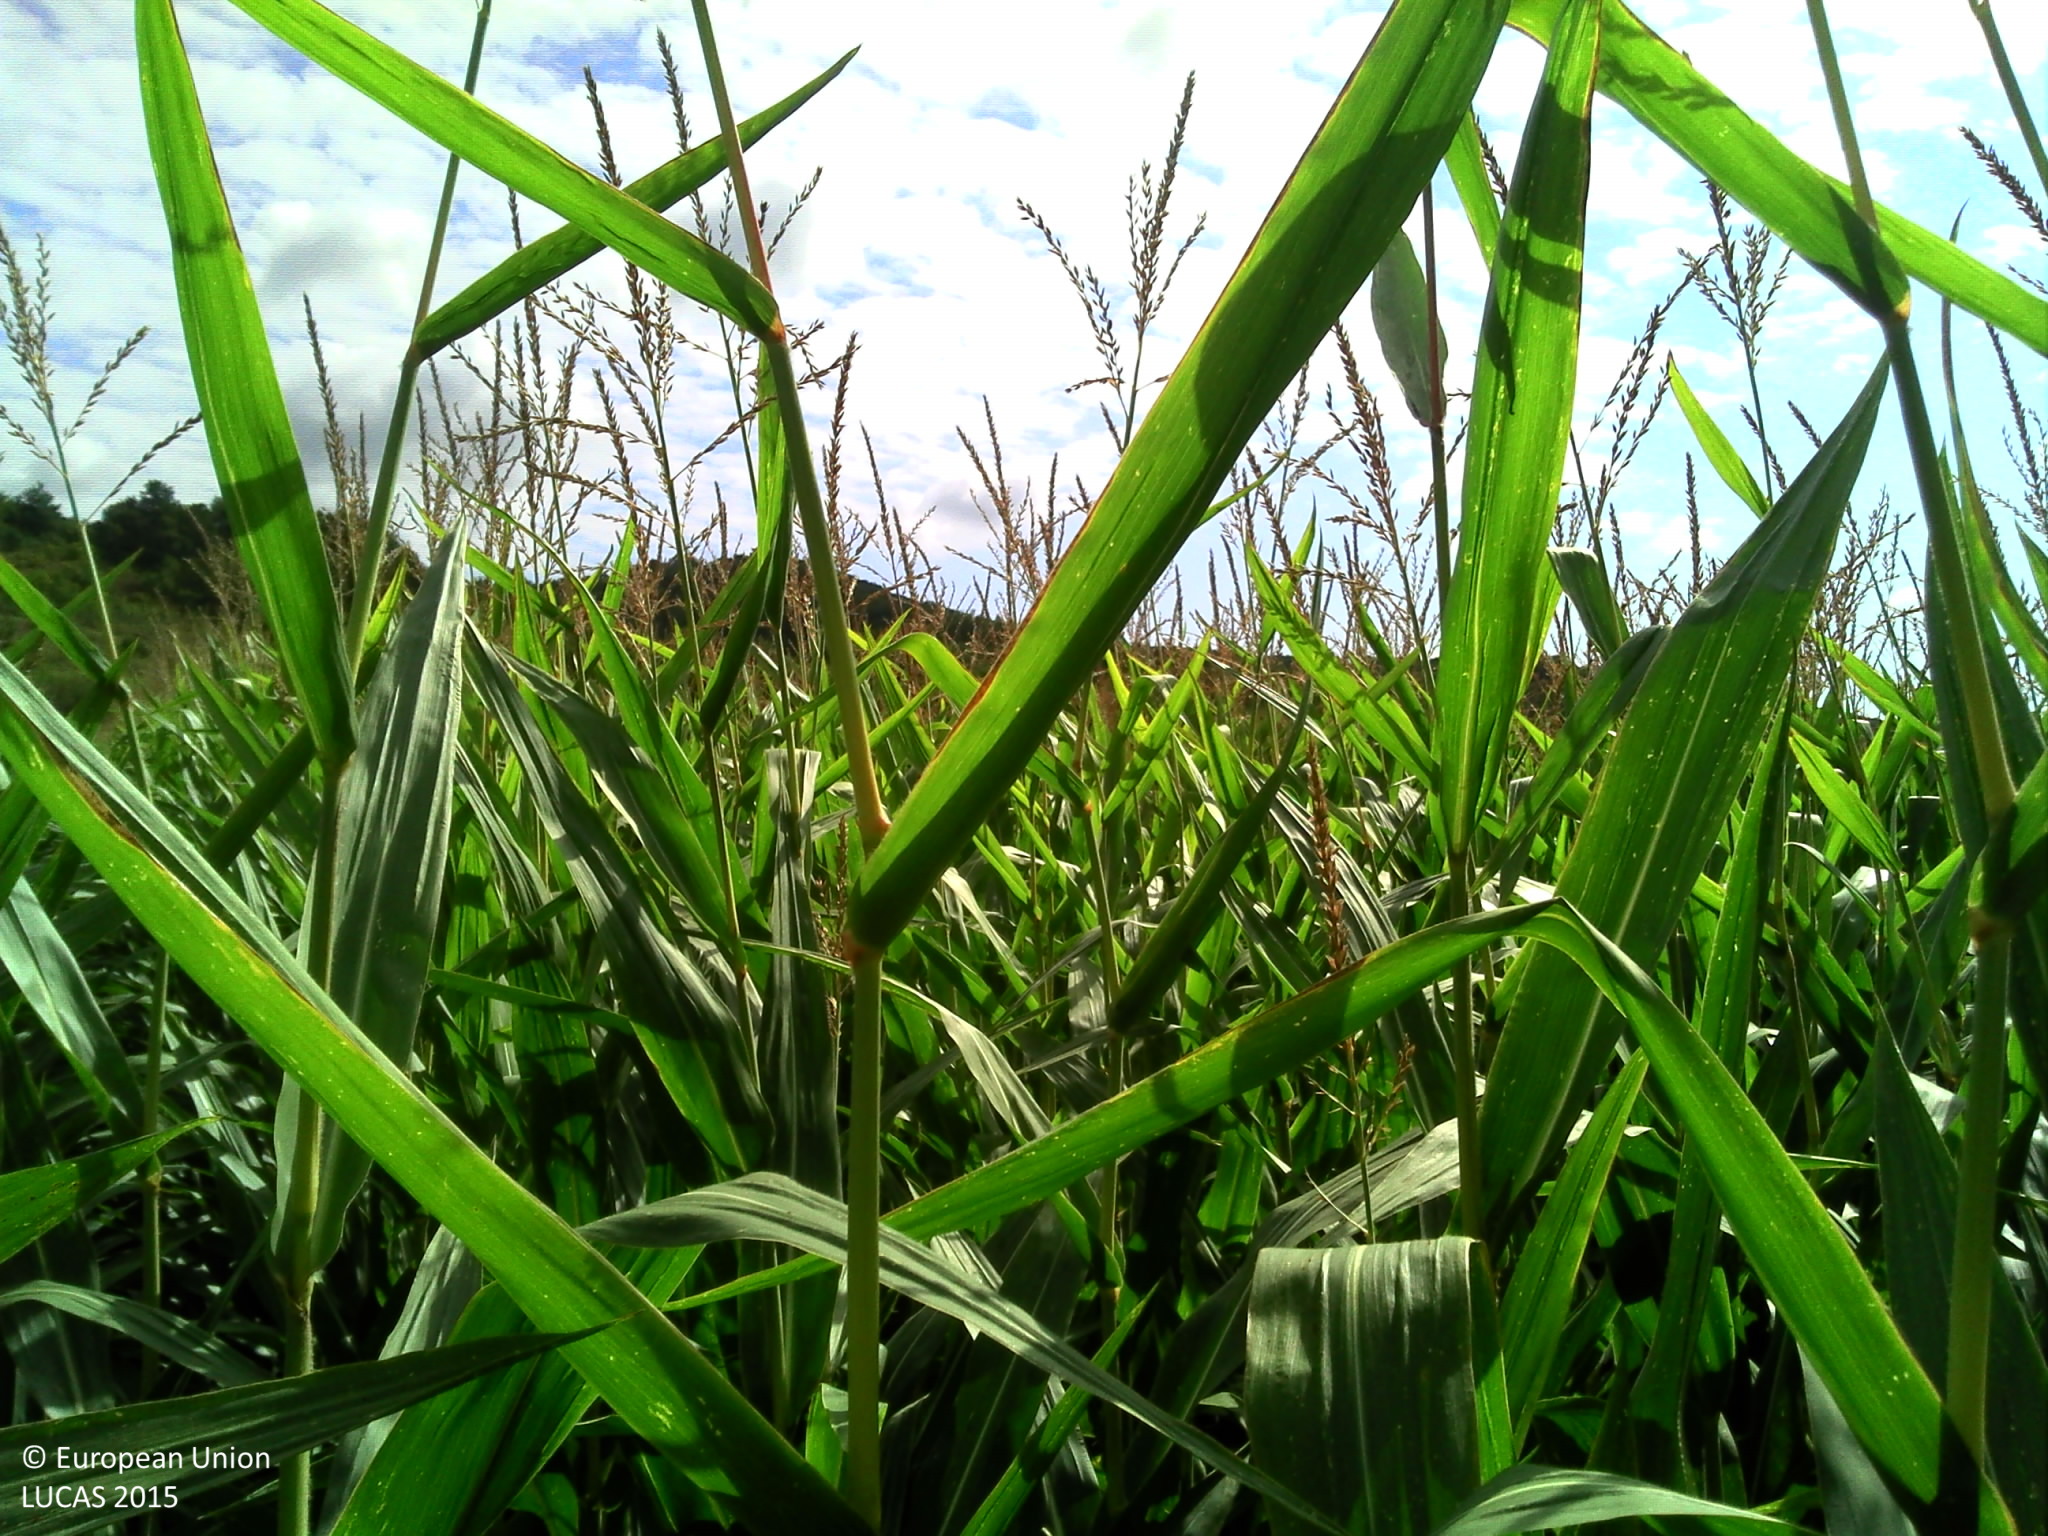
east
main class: Cropland
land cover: Maize
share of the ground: > 75 %
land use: Agriculture (excluding fallow land and kitchen gardens)
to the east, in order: Maize; Grass margins; Ditches and canals; Grass margins; Maize
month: September
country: FR
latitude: 43.5743
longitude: -0.1983
